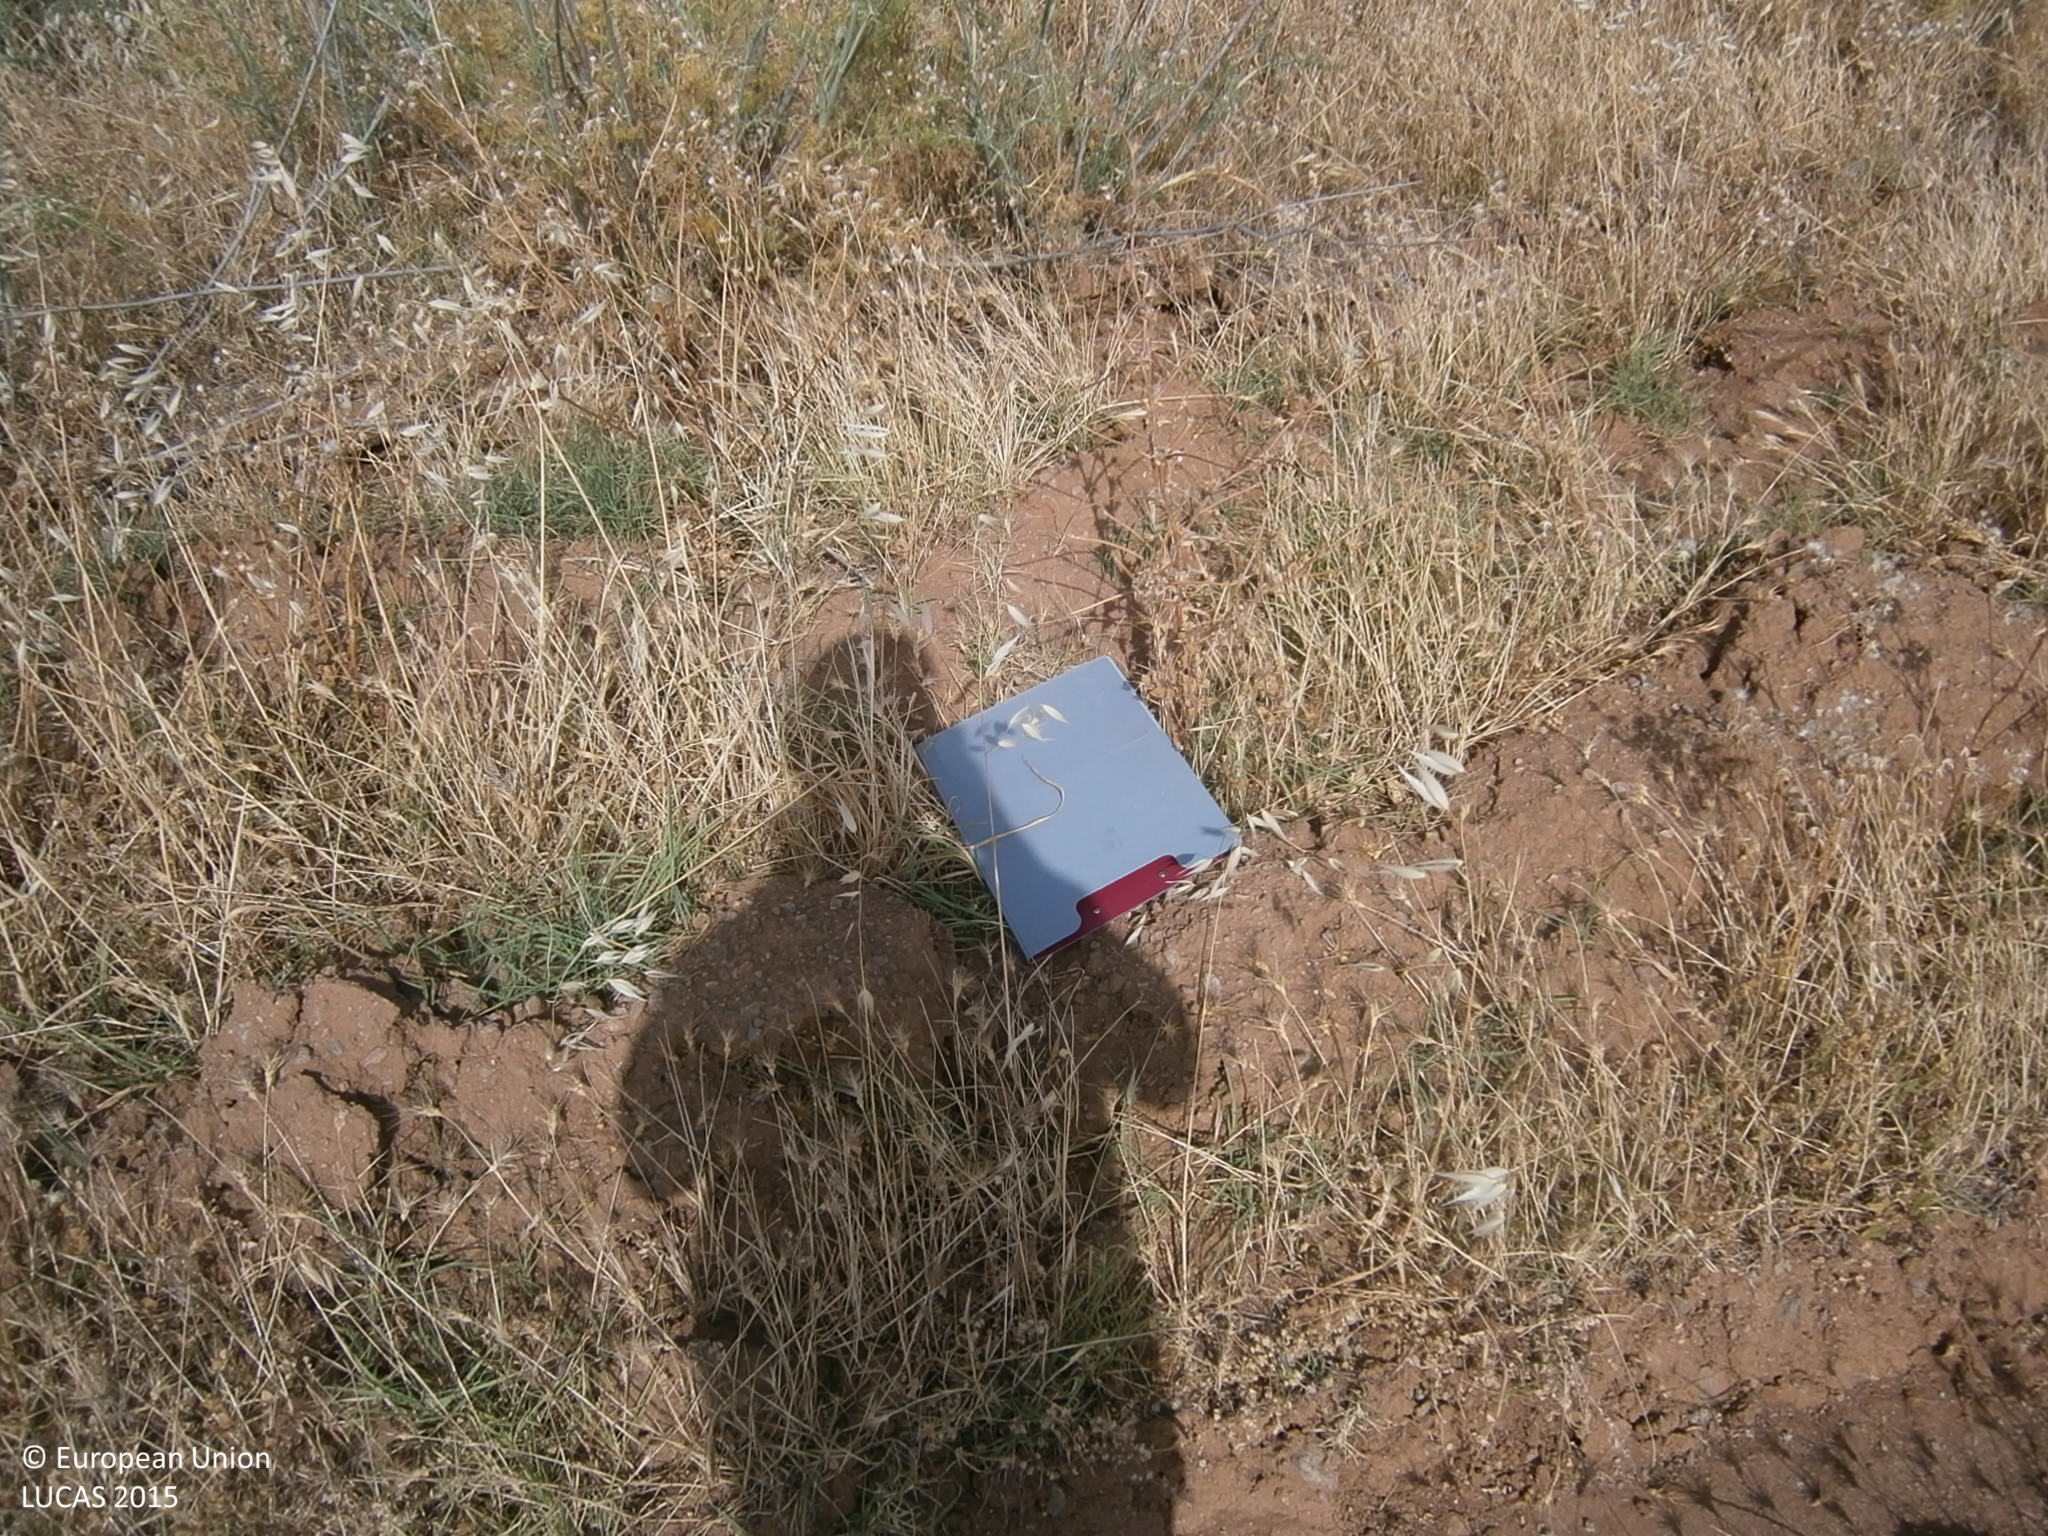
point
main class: Grassland
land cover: Grassland without tree/shrub cover
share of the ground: > 75 %
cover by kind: herbaceous plants 95 %
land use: Agriculture (excluding fallow land and kitchen gardens)
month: June
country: ES
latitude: 38.8936
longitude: -6.3014
